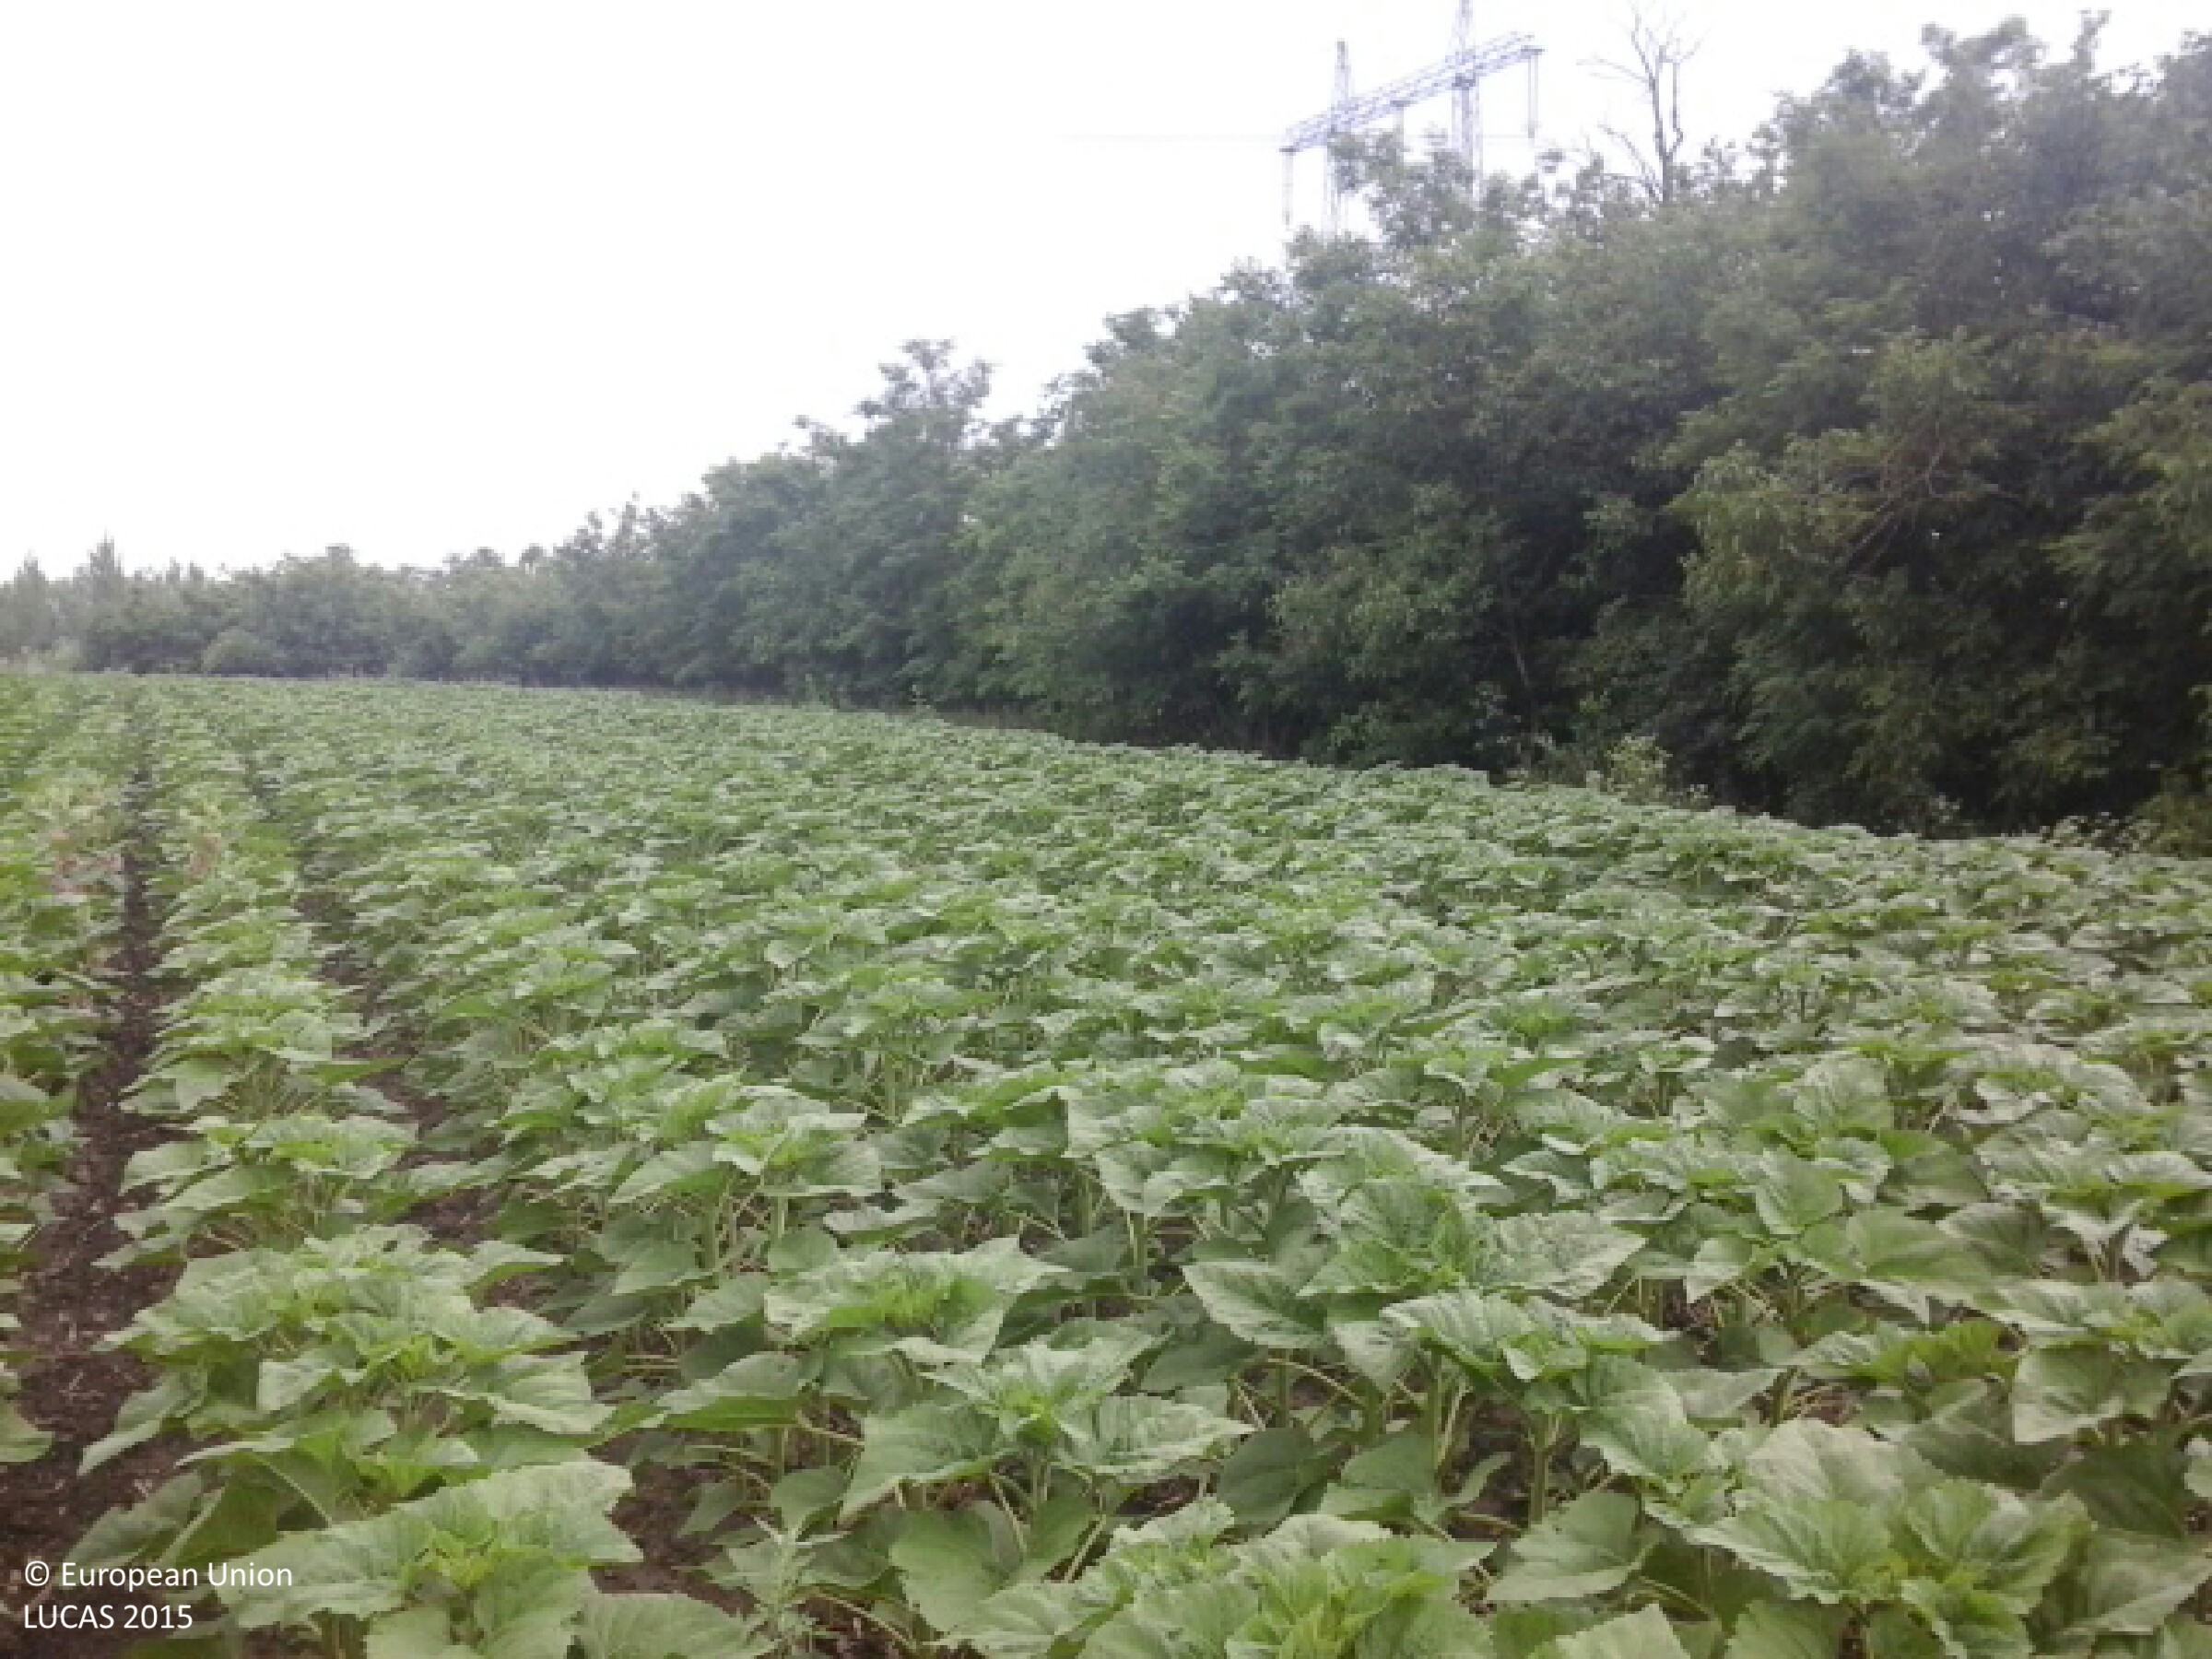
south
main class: Cropland
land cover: Sunflower
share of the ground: 50 - 75 %
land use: Agriculture (excluding fallow land and kitchen gardens)
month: June
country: HU
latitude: 48.0937
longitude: 21.8253
